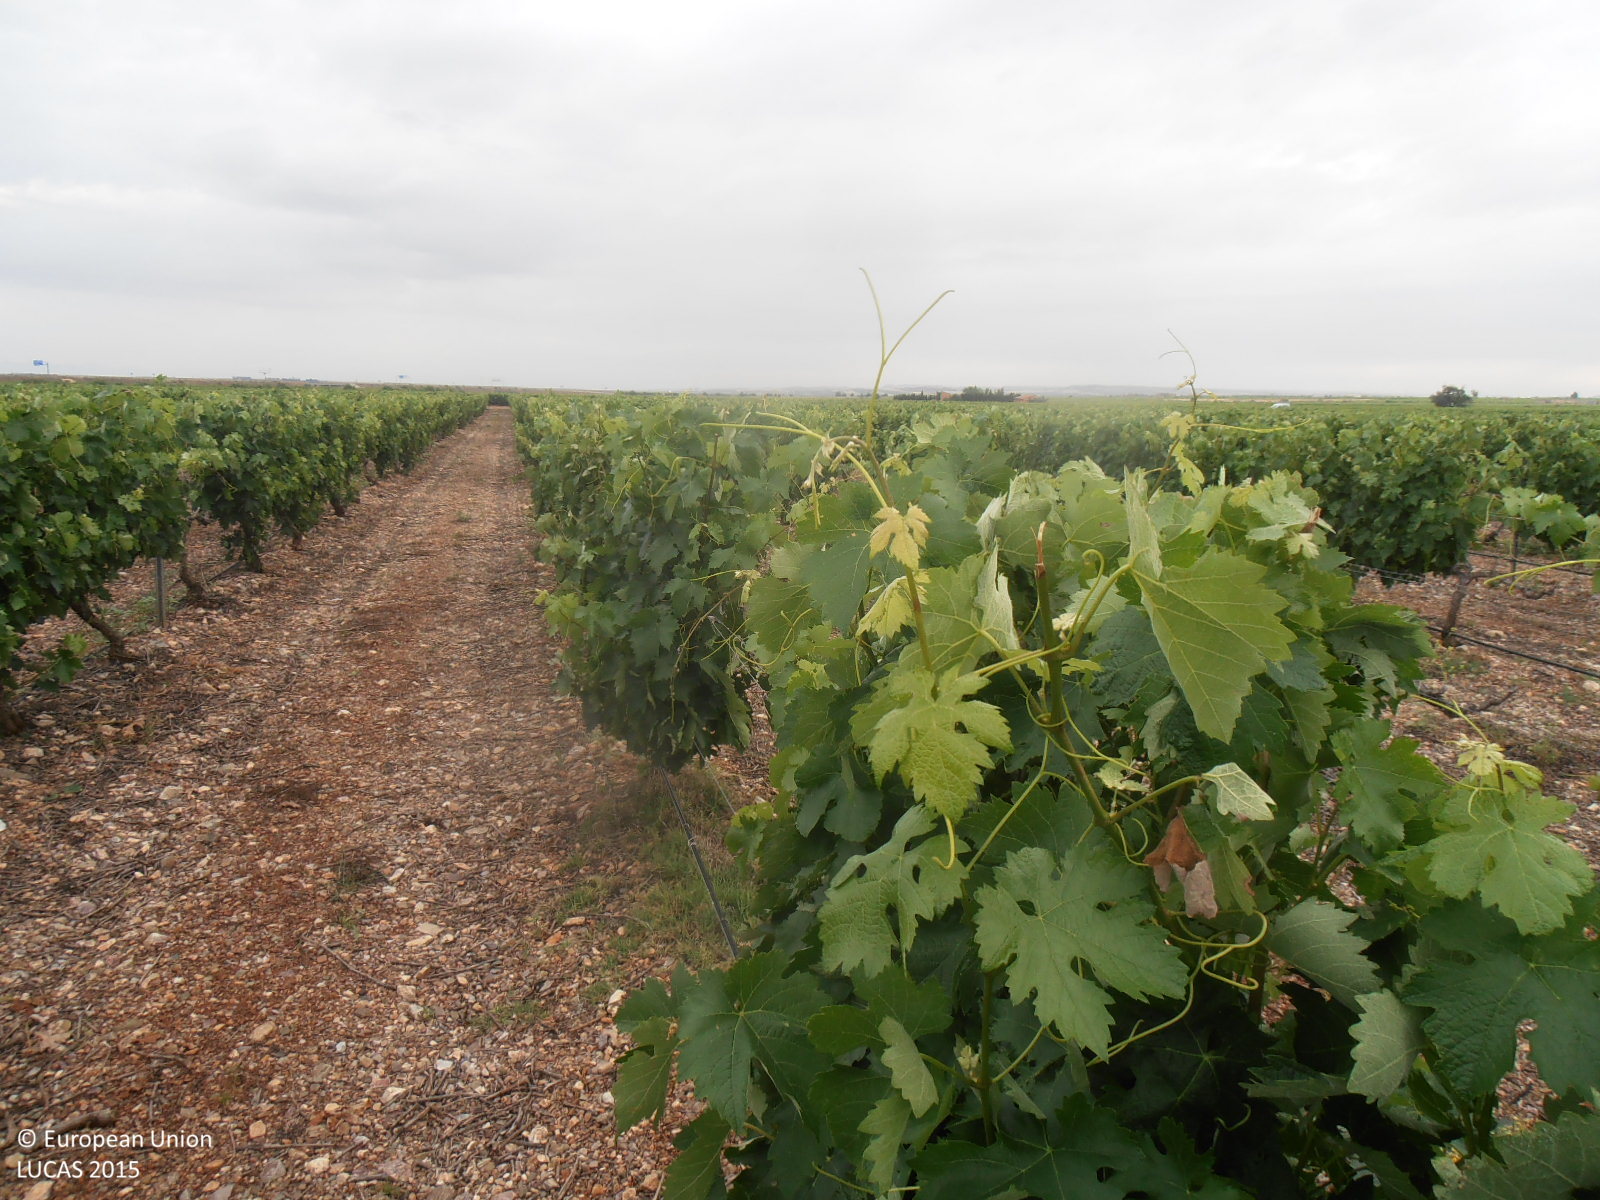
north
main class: Cropland
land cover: Vineyards
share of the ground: 10 - 25 %
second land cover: Other bare soil
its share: > 75 %
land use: Agriculture (excluding fallow land and kitchen gardens)
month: June
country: ES
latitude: 41.3569
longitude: -1.1977
